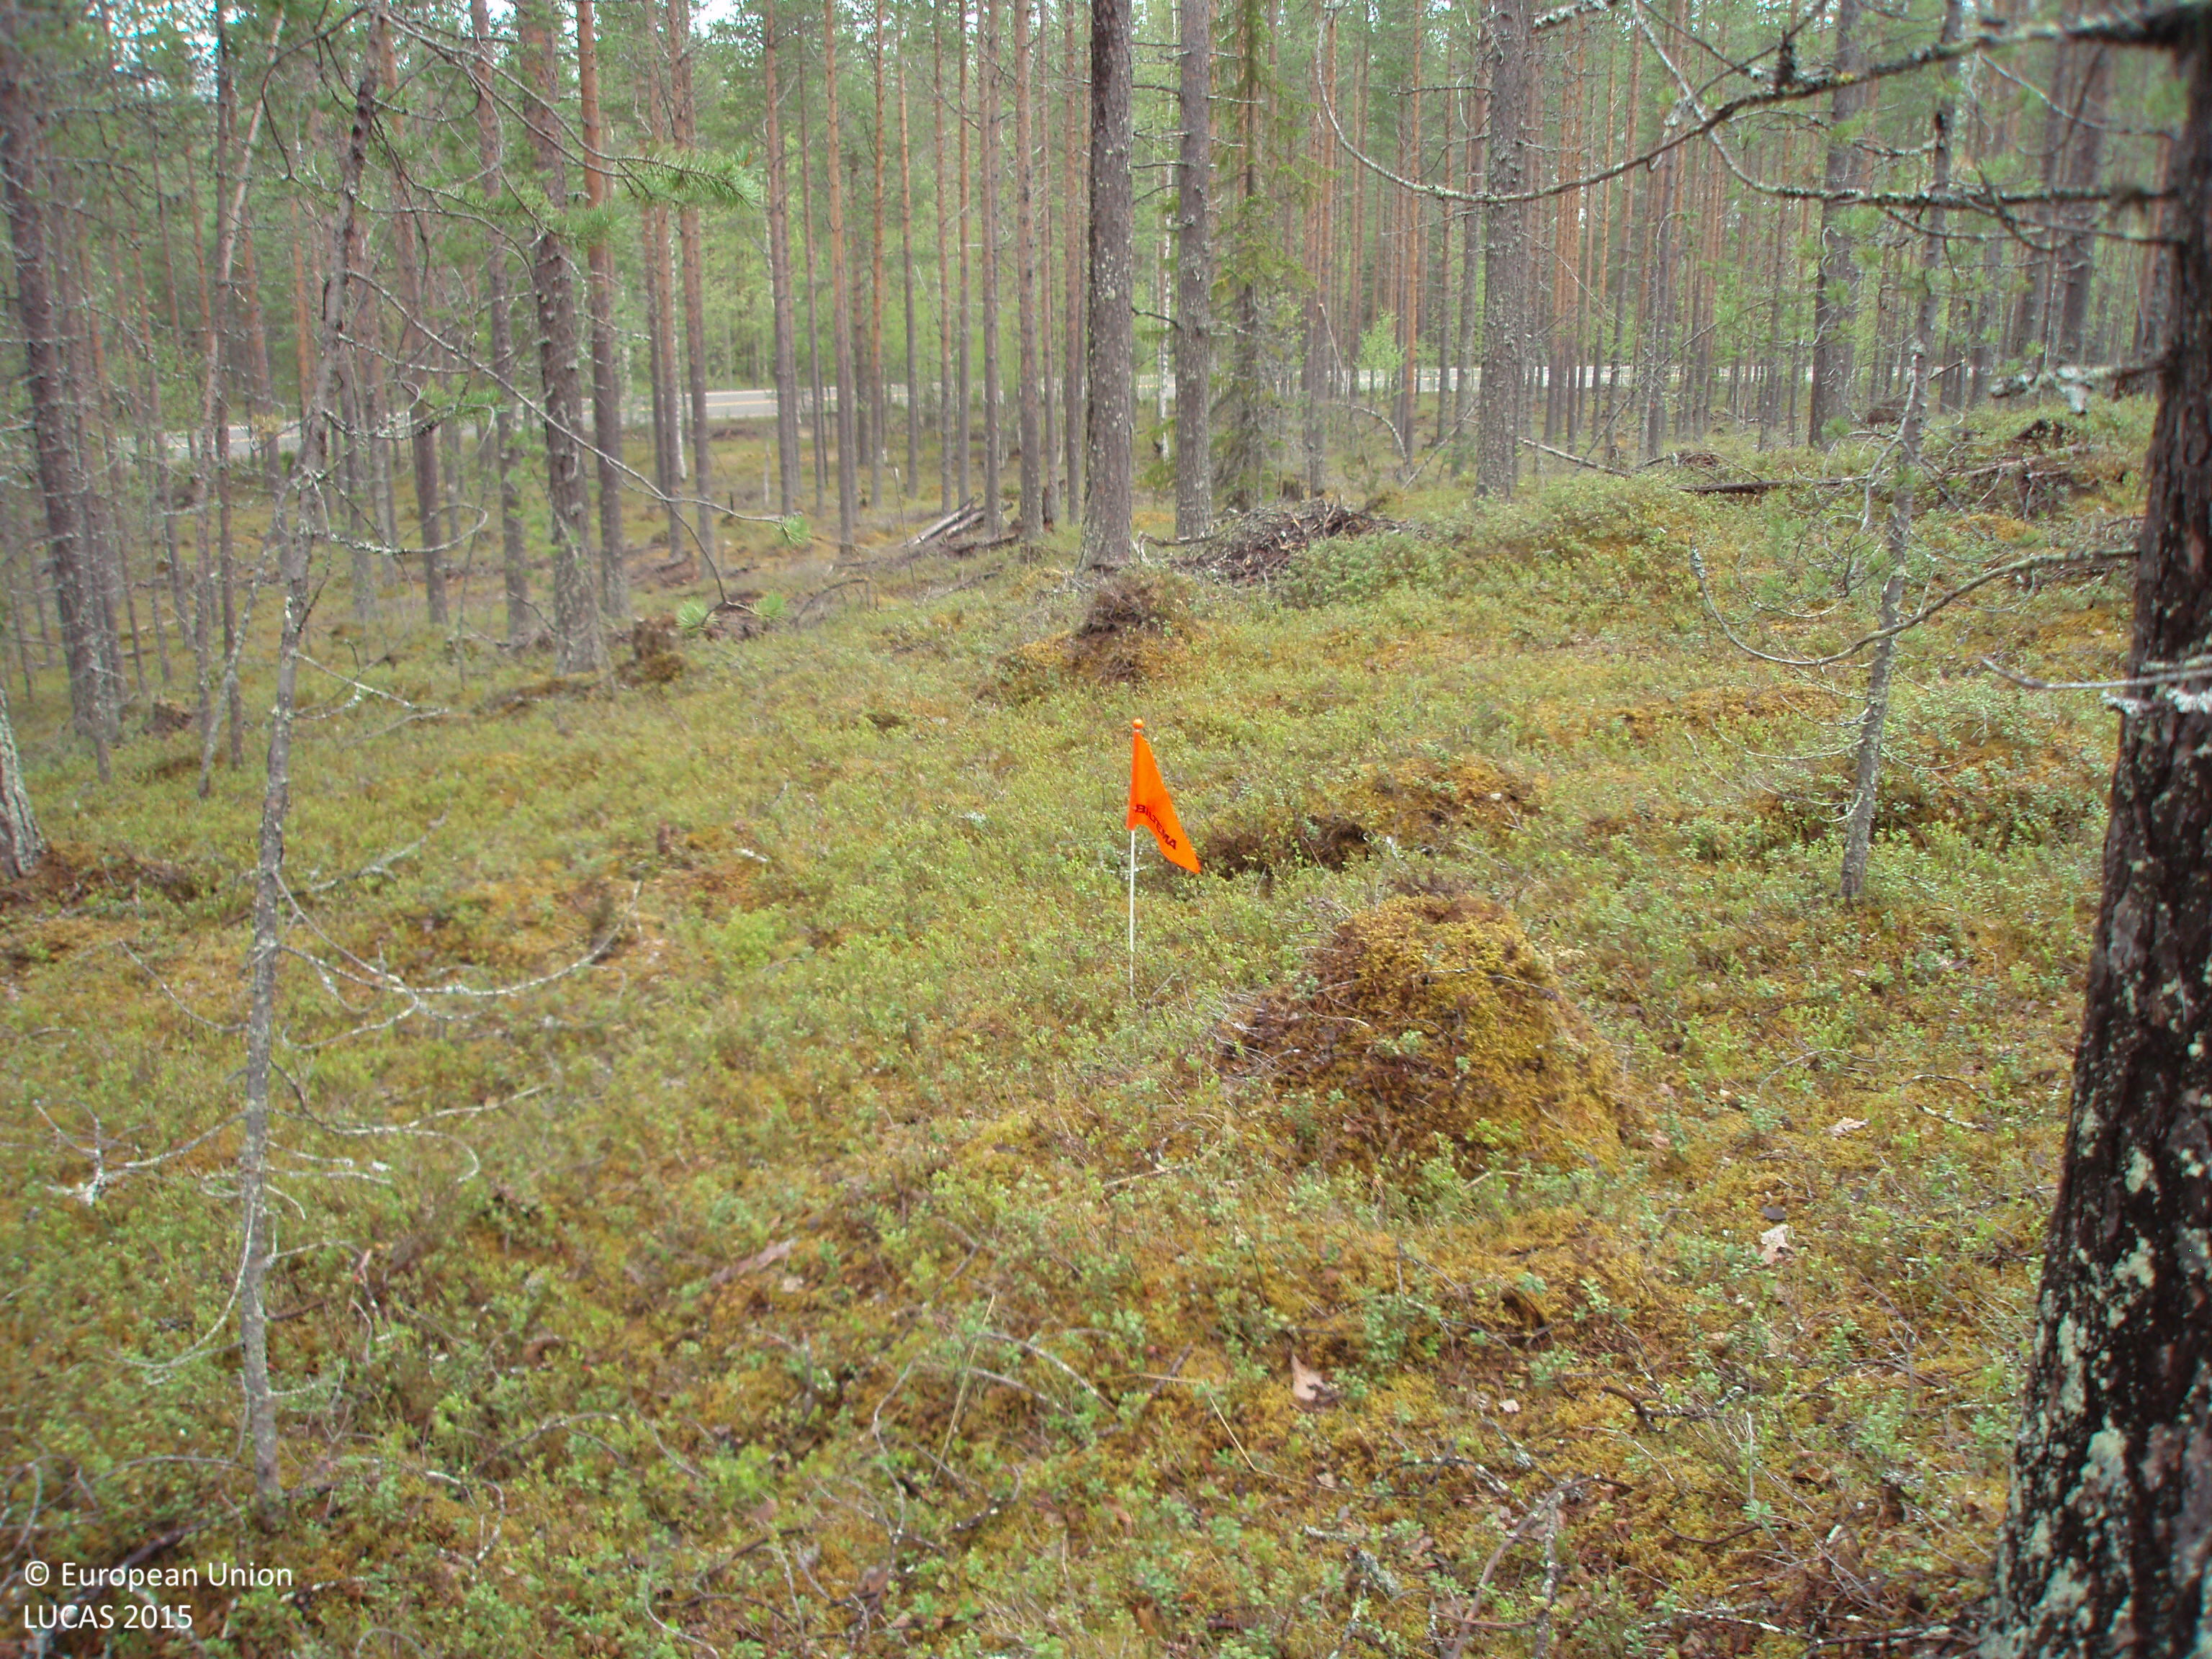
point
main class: Woodland
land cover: Pine dominated coniferous woodland
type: boreal forest
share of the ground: 50 - 75 %
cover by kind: coniferous forest trees 60 %, shrubs 30 %, broadleaved forest trees 10 %
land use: Forestry
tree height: > 5 m
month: June
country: FI
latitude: 66.5696
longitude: 27.2567
